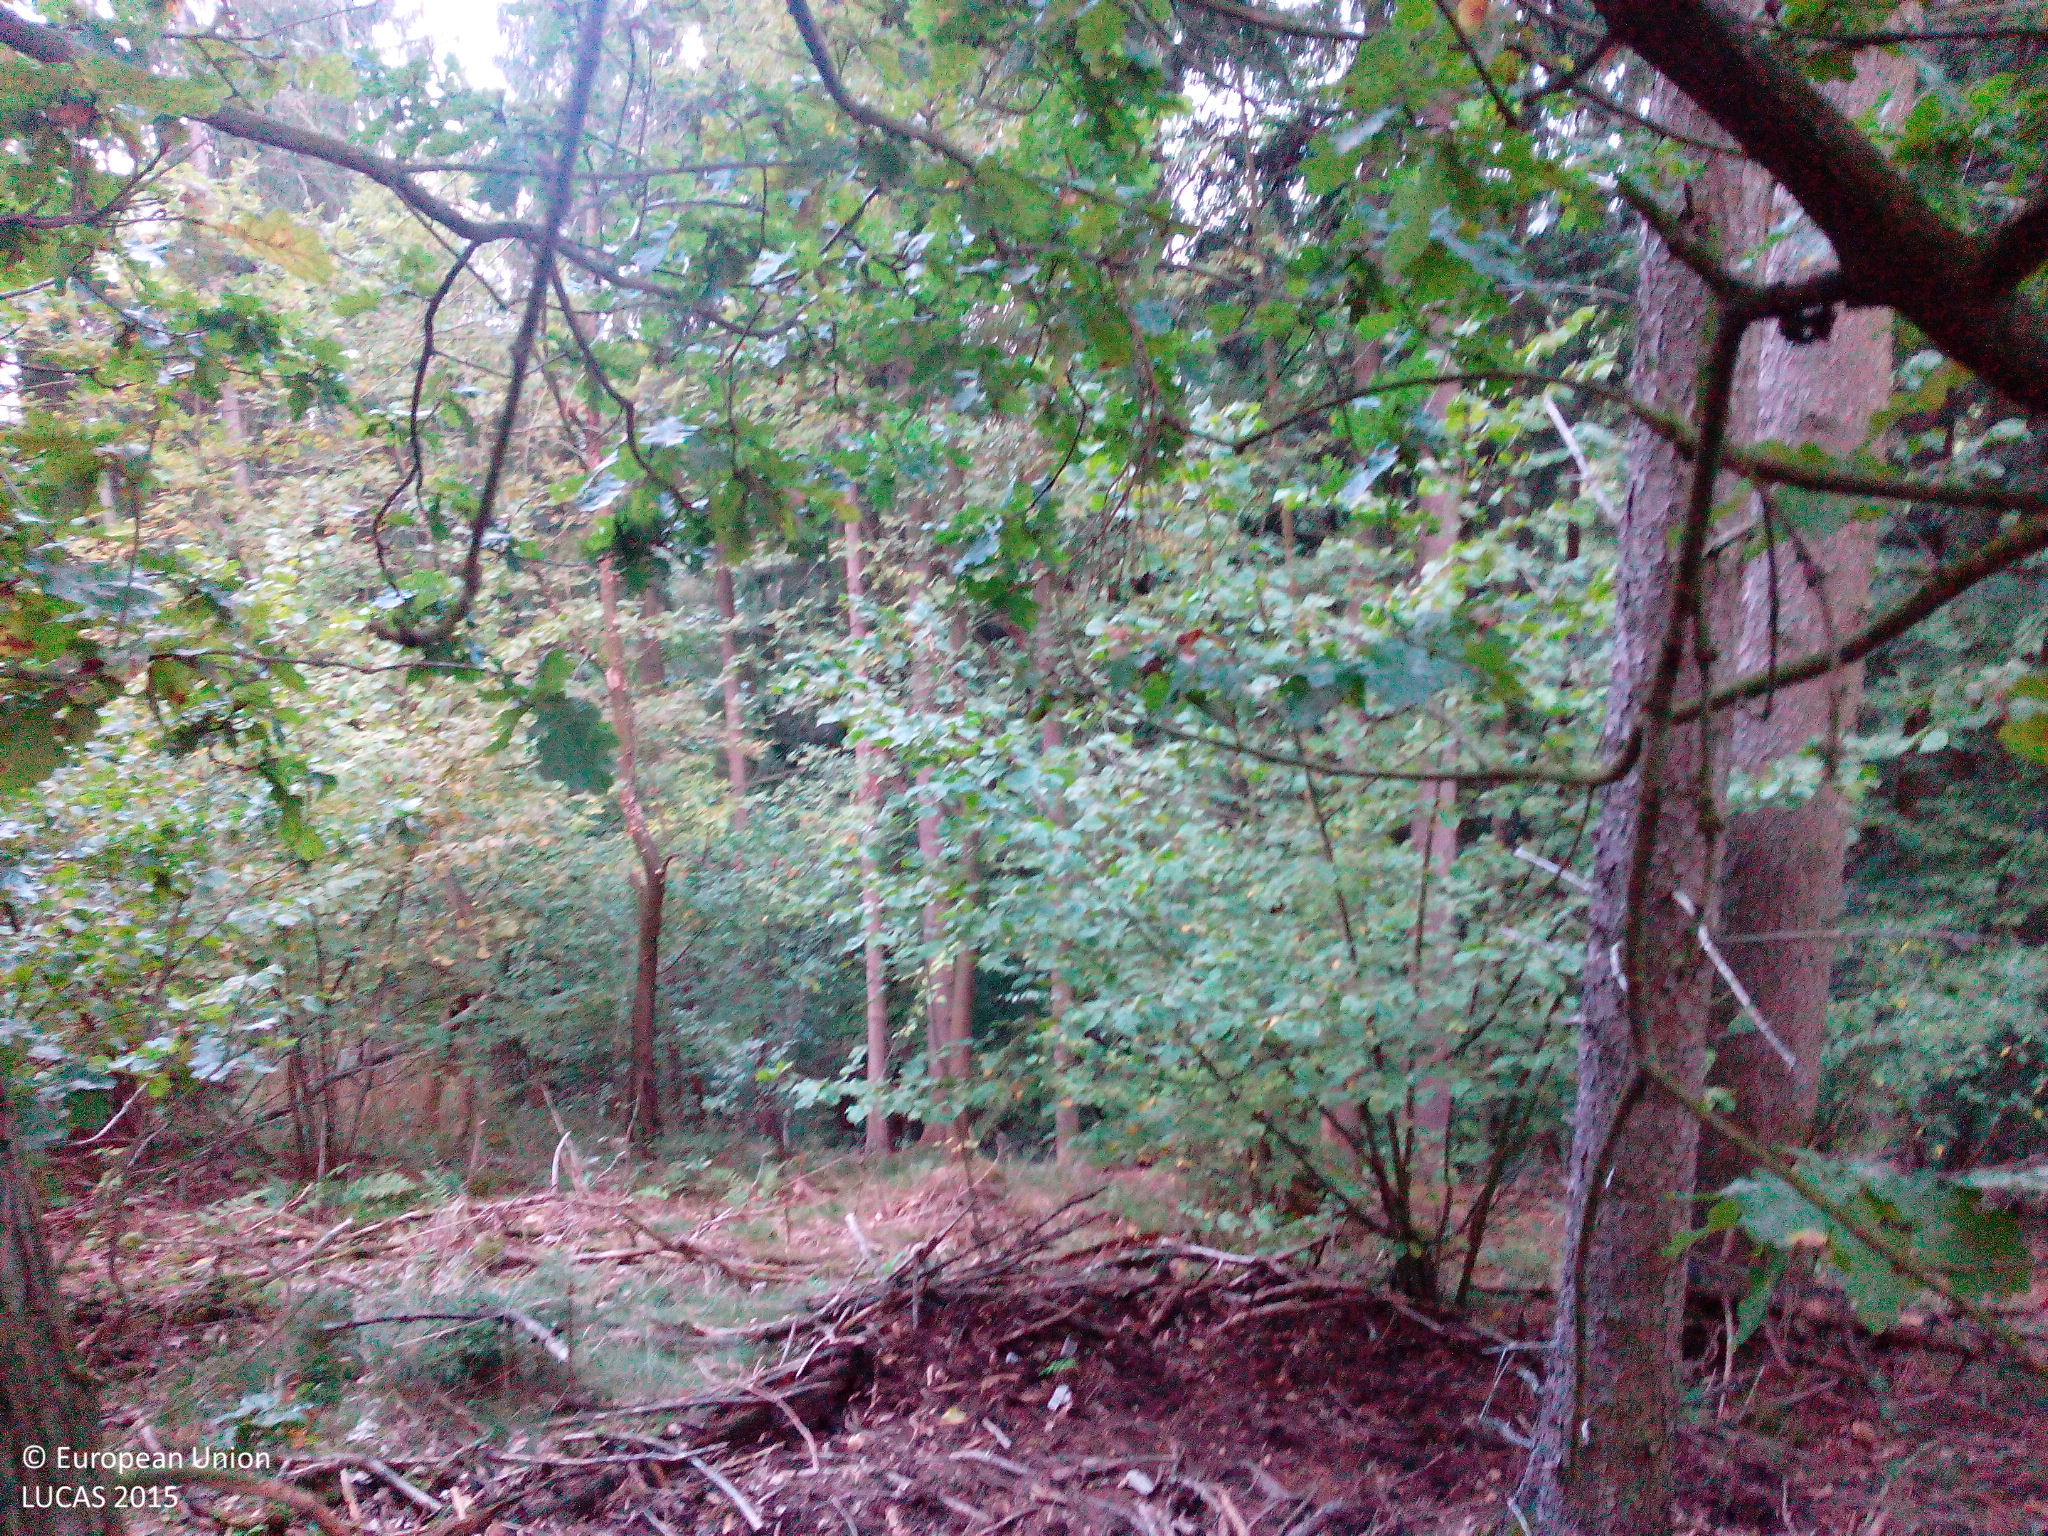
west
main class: Woodland
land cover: Spruce dominated mixed woodland
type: hemiboreal forest and nemoral coniferous forest and mixed broadleaved-coniferous forest
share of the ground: > 75 %
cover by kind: coniferous forest trees 75 %, broadleaved forest trees 25 %
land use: Forestry
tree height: > 5 m
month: September
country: DE
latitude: 51.4929
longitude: 10.9359
